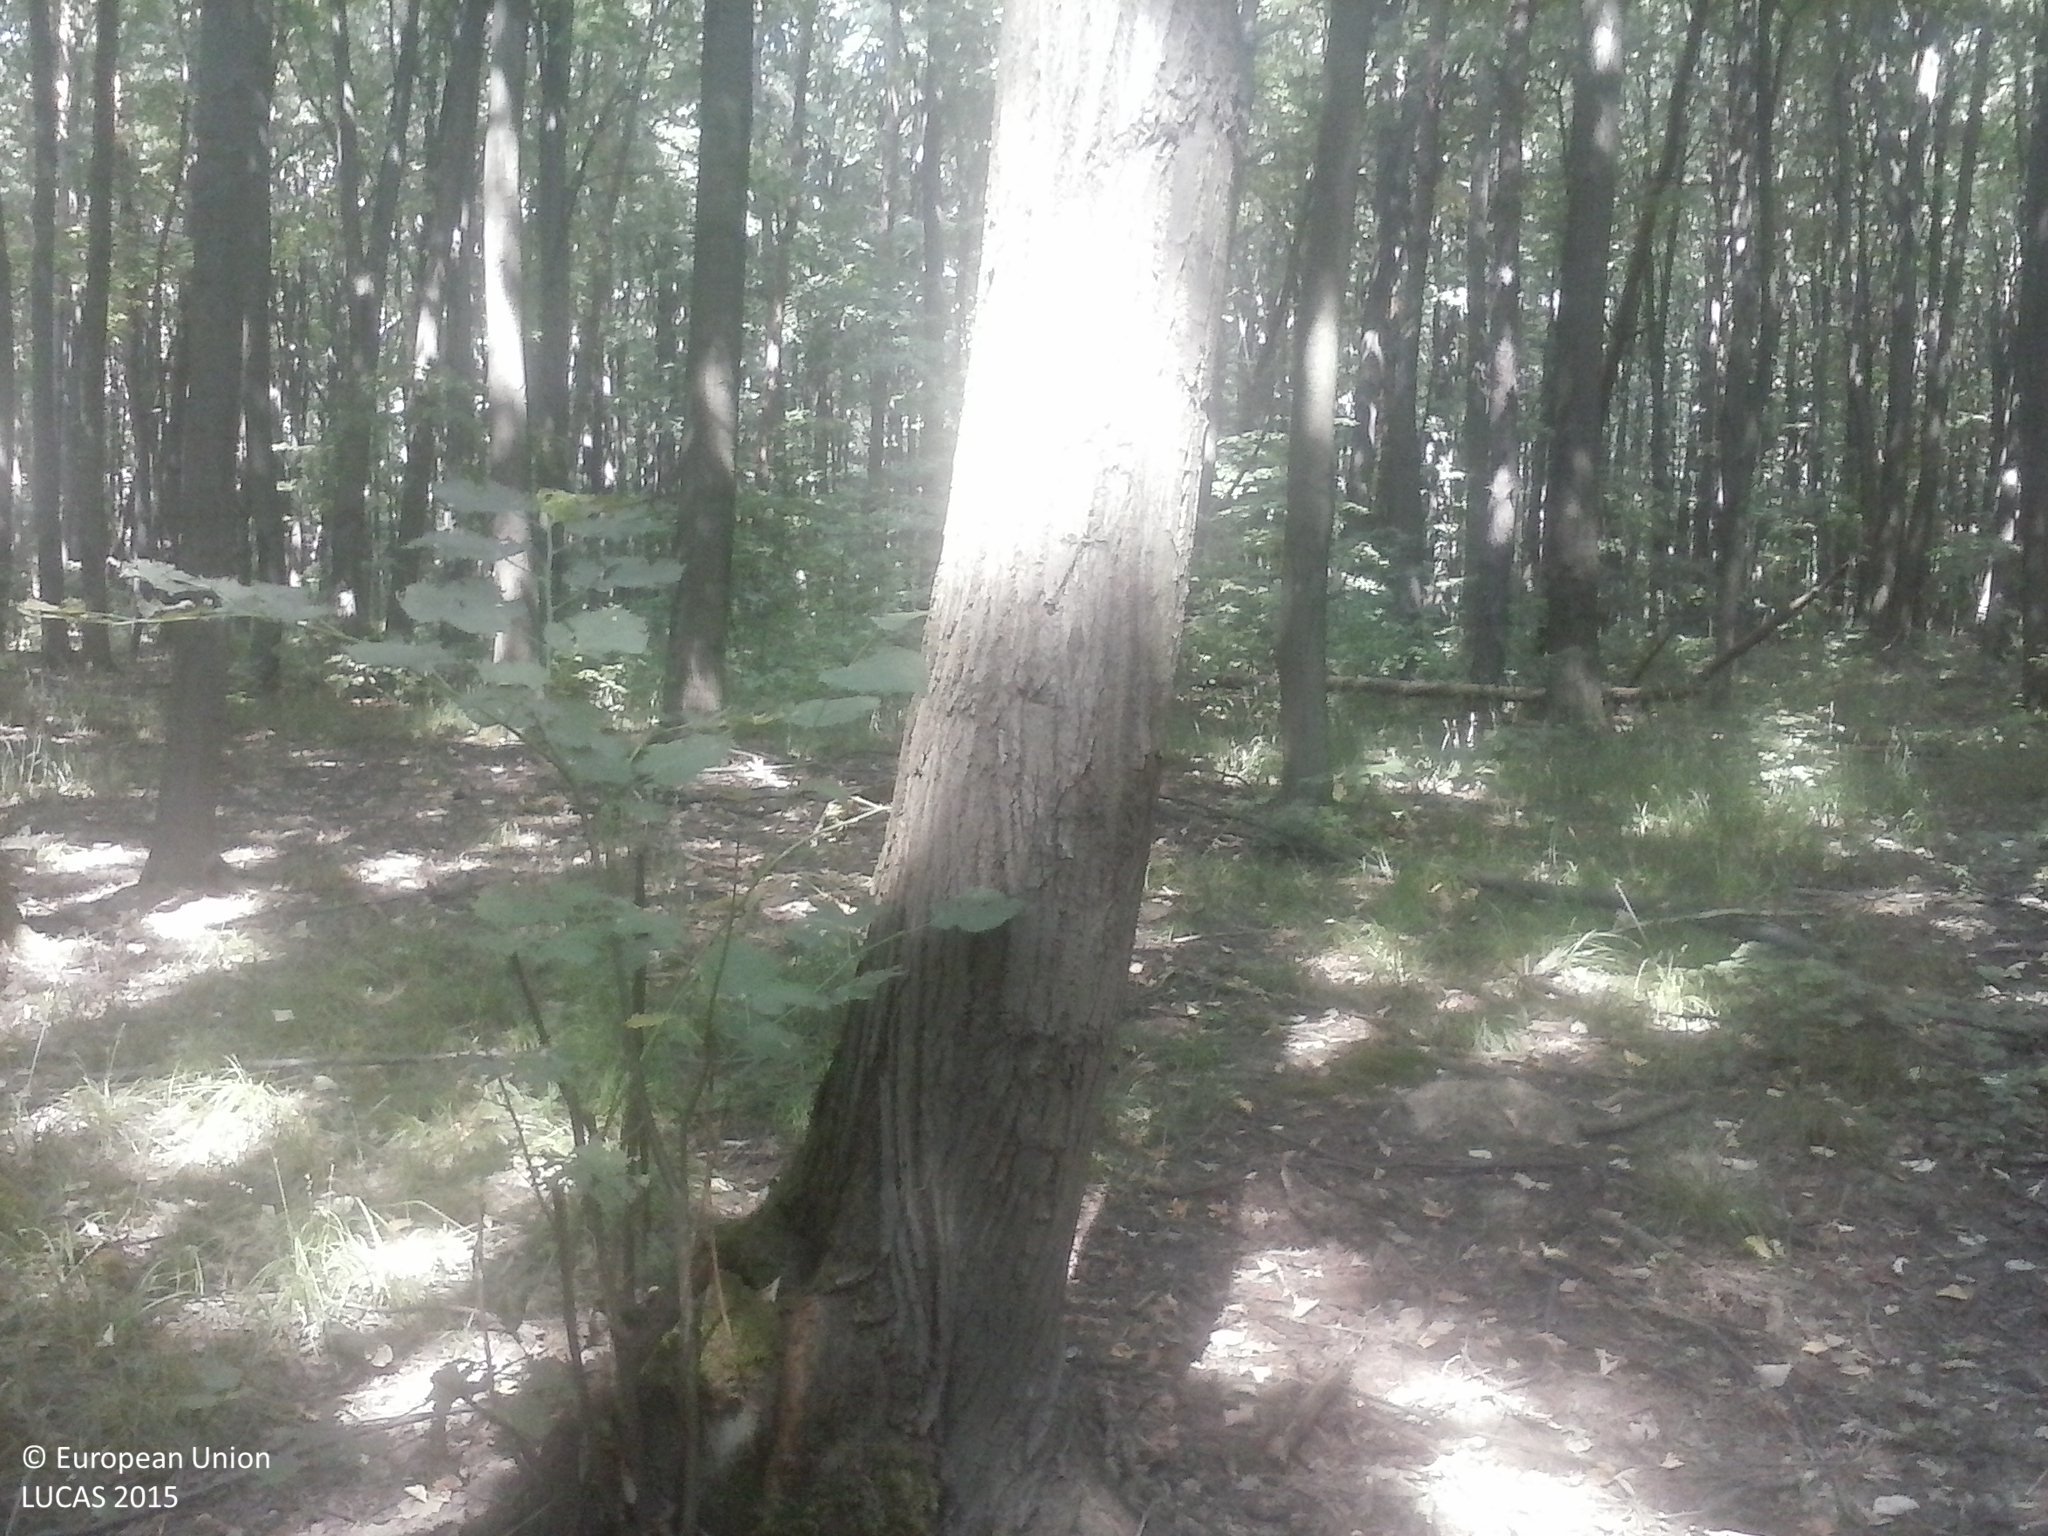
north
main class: Woodland
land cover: Broadleaved woodland
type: beech forest
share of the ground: > 75 %
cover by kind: broadleaved forest trees 100 %
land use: Forestry
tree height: > 5 m
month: August
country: HU
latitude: 46.0962
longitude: 17.8827
